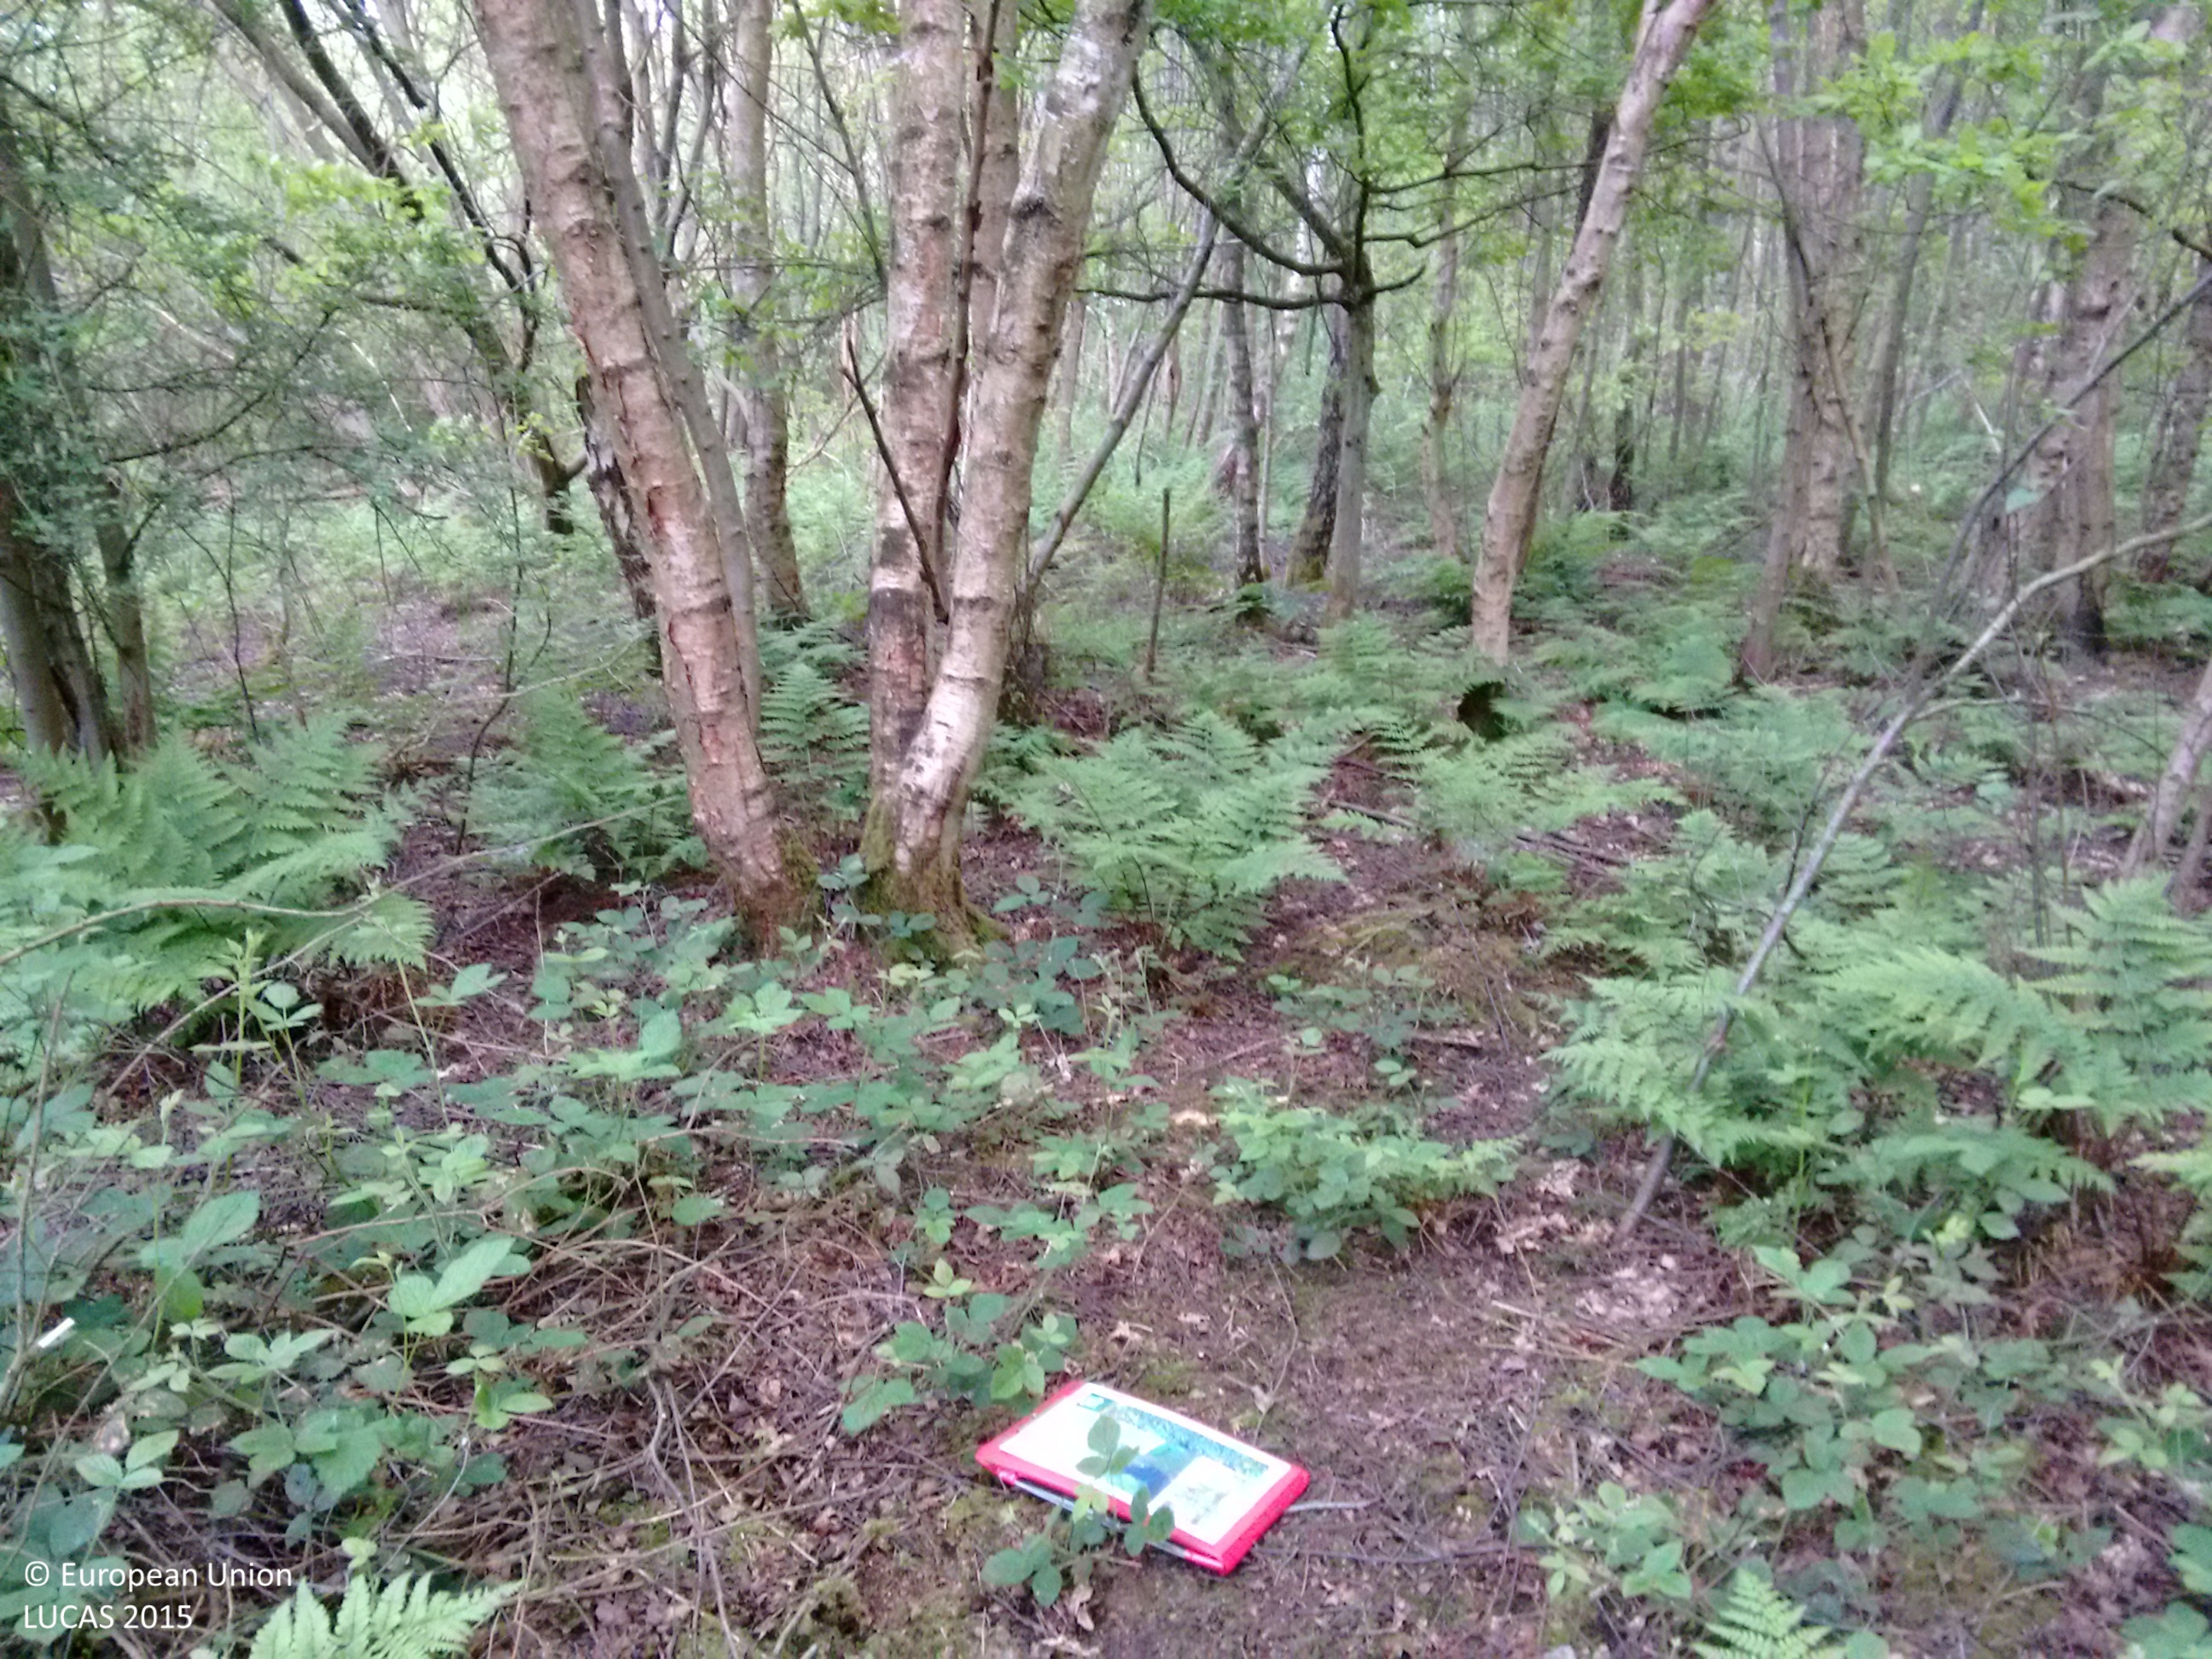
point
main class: Woodland
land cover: Broadleaved woodland
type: acidophilous oak and oak-birch forest
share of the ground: > 75 %
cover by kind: broadleaved forest trees 100 %
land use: Forestry
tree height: > 5 m
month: May
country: GB
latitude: 53.4823
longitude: -0.3580
